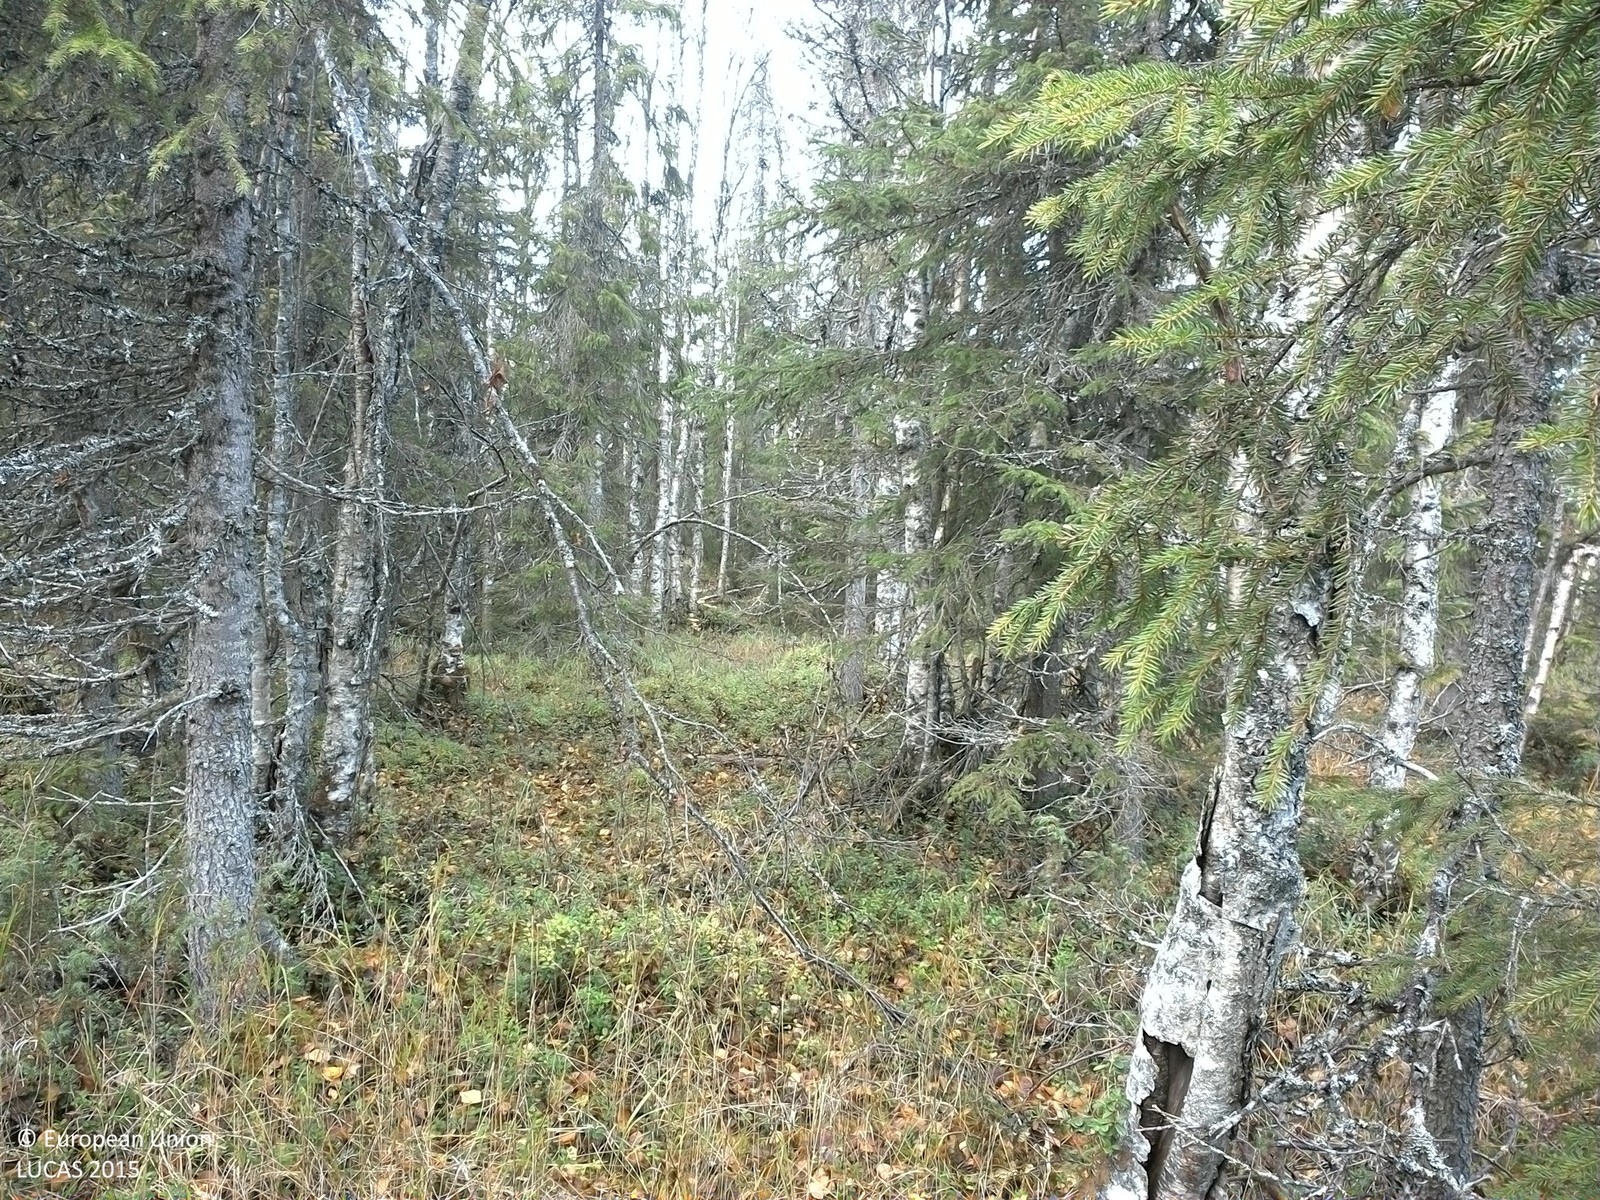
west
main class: Woodland
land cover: Spruce dominated mixed woodland
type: boreal forest
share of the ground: 50 - 75 %
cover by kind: coniferous forest trees 35 %, broadleaved forest trees 25 %, shrubs 15 %, herbaceous plants 15 %, lichens and mosses 10 %
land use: Forestry
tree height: > 5 m
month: October
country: SE
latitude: 64.3424
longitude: 15.9106
